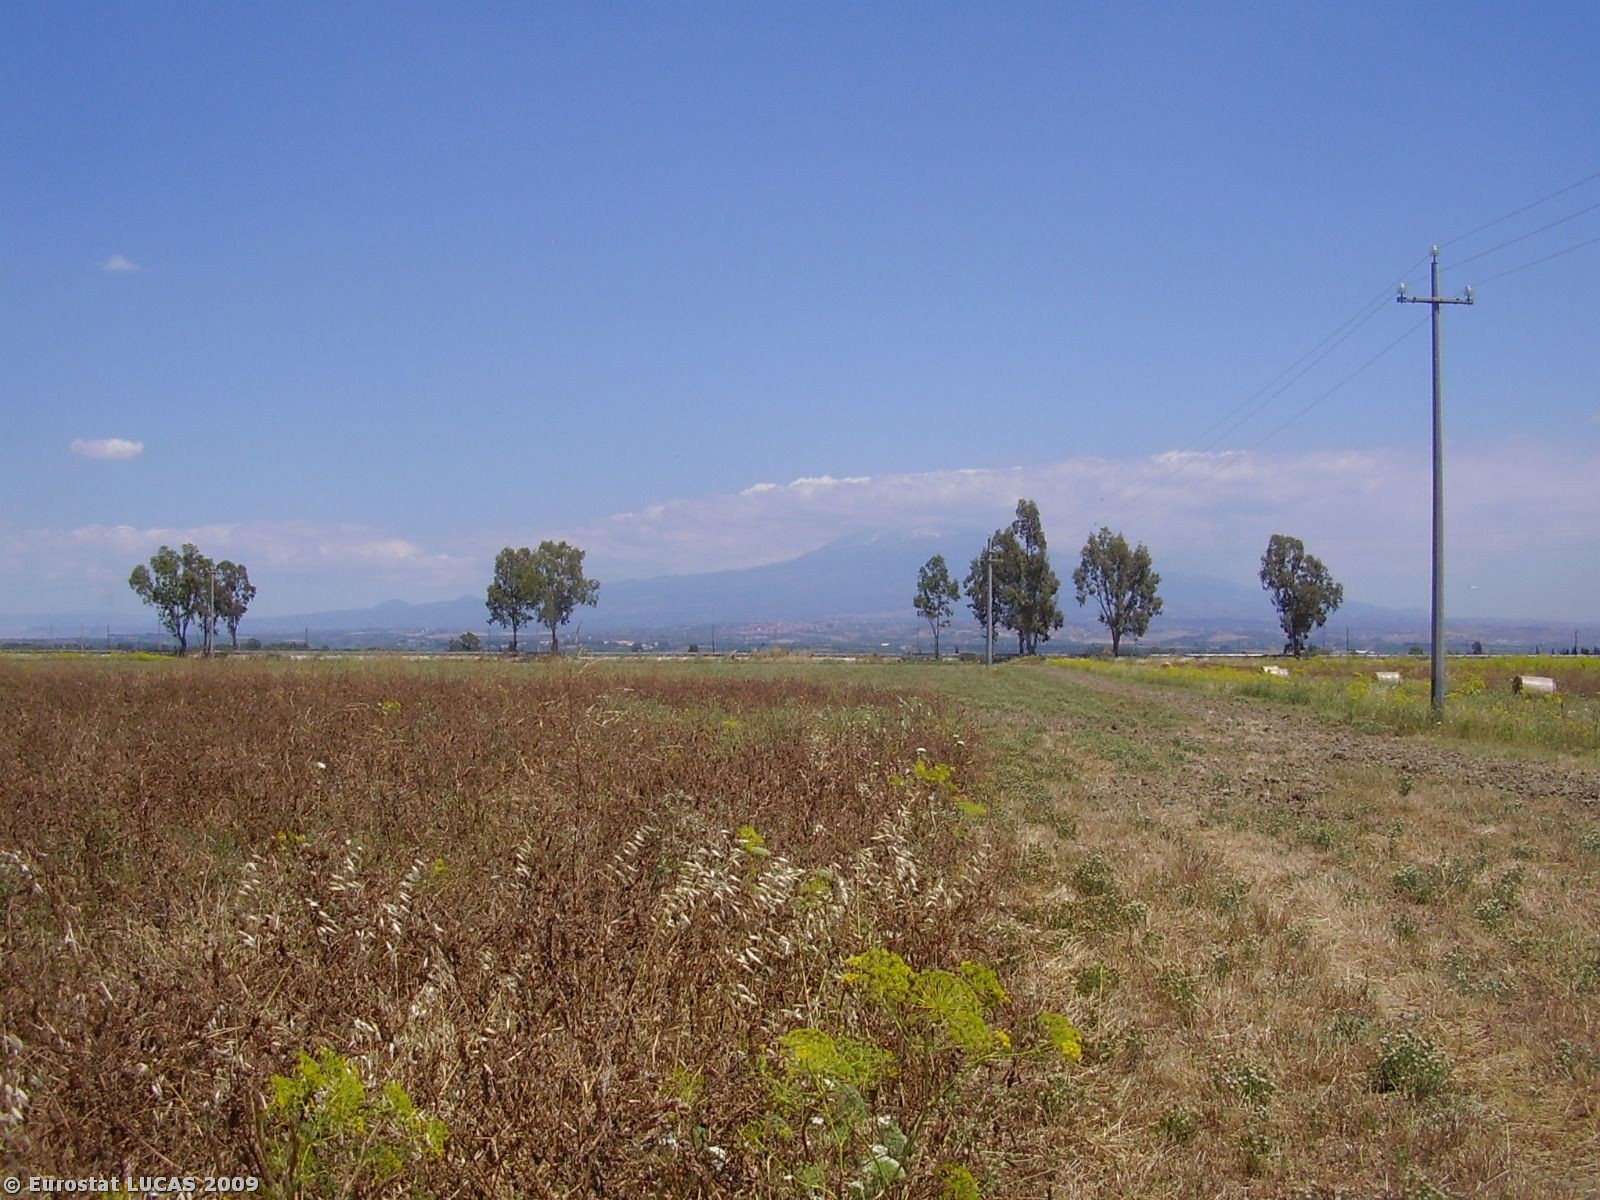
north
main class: Cropland
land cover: Other cereals
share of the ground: > 75 %
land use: Agriculture (excluding fallow land and kitchen gardens)
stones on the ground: < 10 %
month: June
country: IT
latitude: 37.3994
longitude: 14.9679
